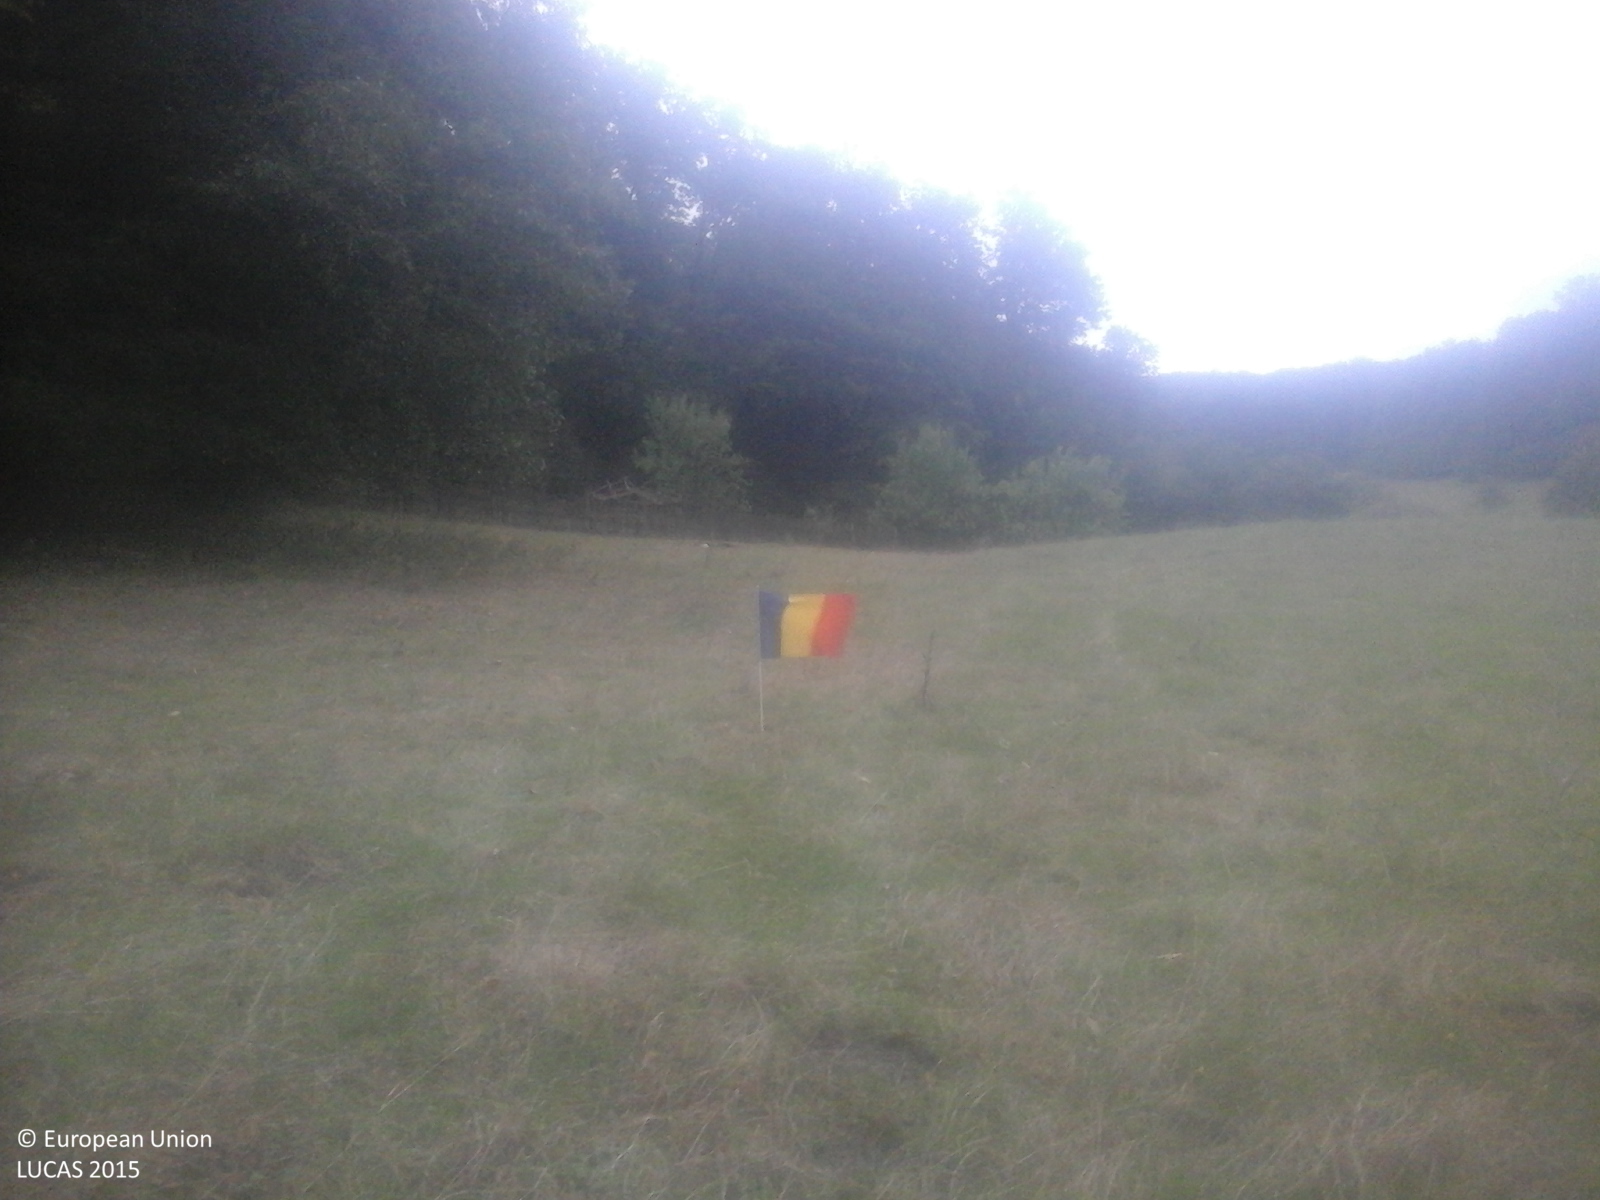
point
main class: Grassland
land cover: Grassland without tree/shrub cover
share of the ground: > 75 %
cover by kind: herbaceous plants 100 %
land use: Agriculture (excluding fallow land and kitchen gardens)
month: September
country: RO
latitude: 45.9190
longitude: 23.4335
